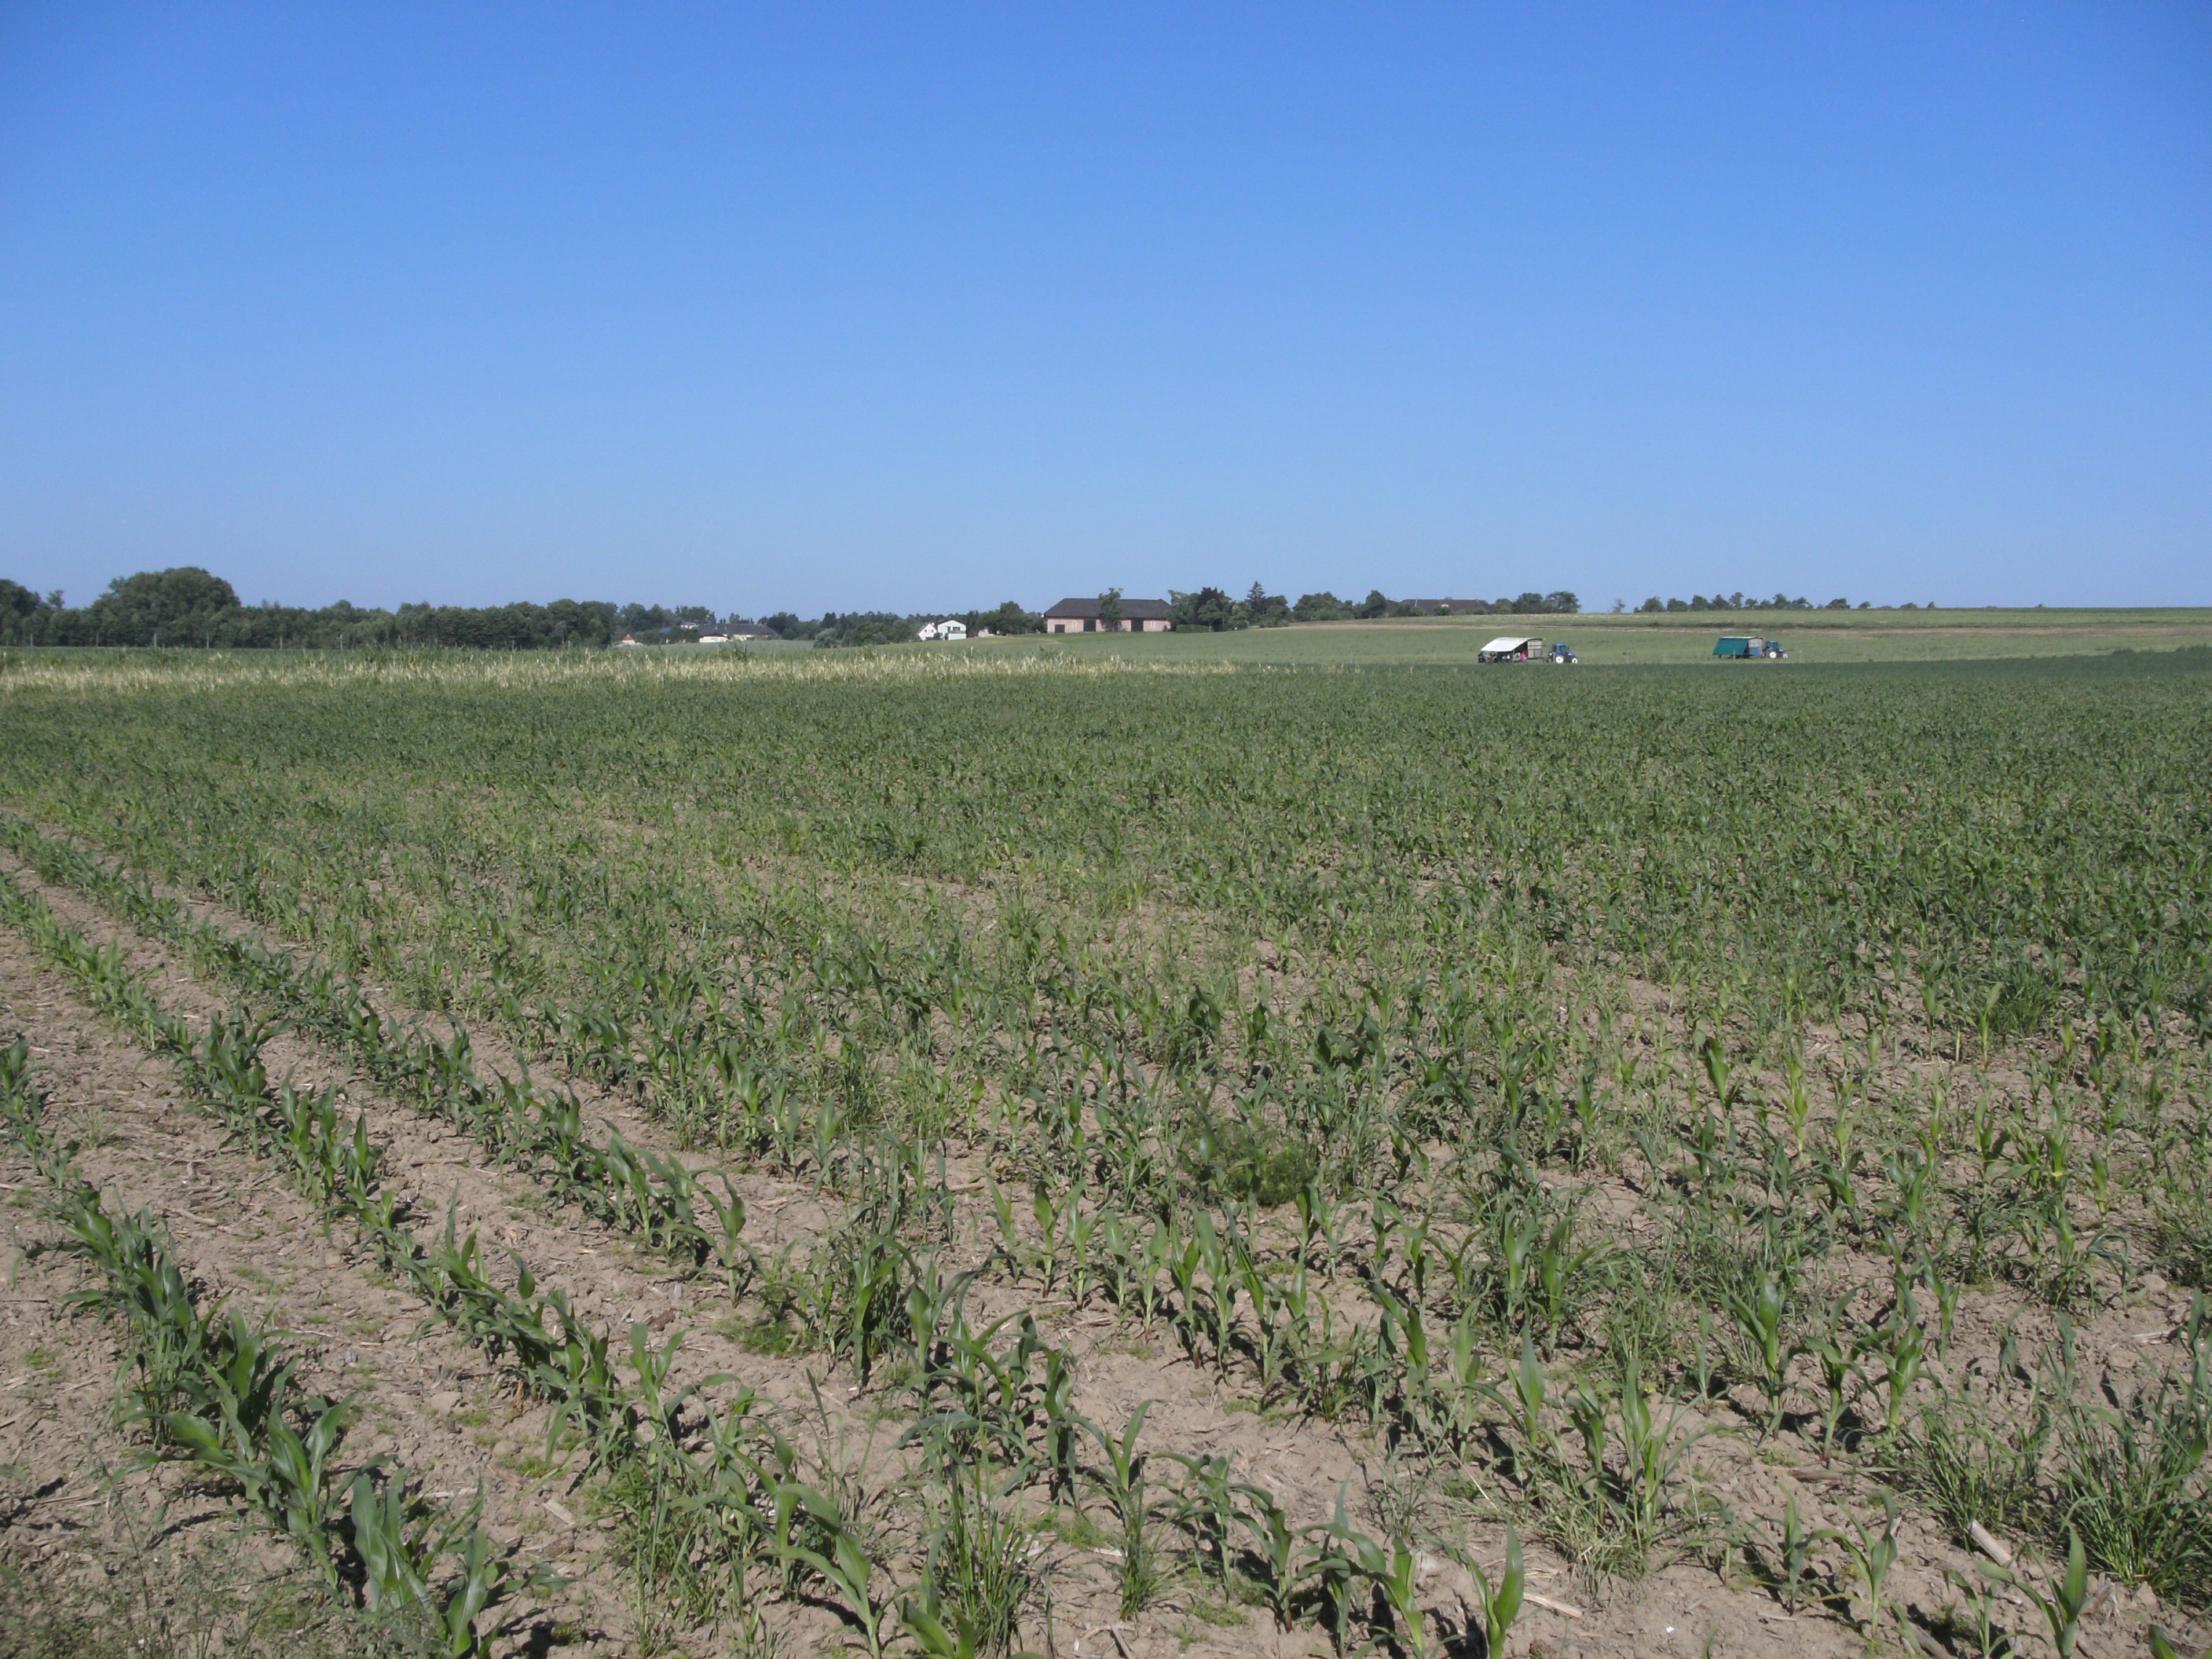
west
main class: Cropland
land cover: Maize
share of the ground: 25 - 50 %
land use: Agriculture (excluding fallow land and kitchen gardens)
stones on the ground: < 10 %
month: June
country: AT
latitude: 48.2032
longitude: 14.0498
